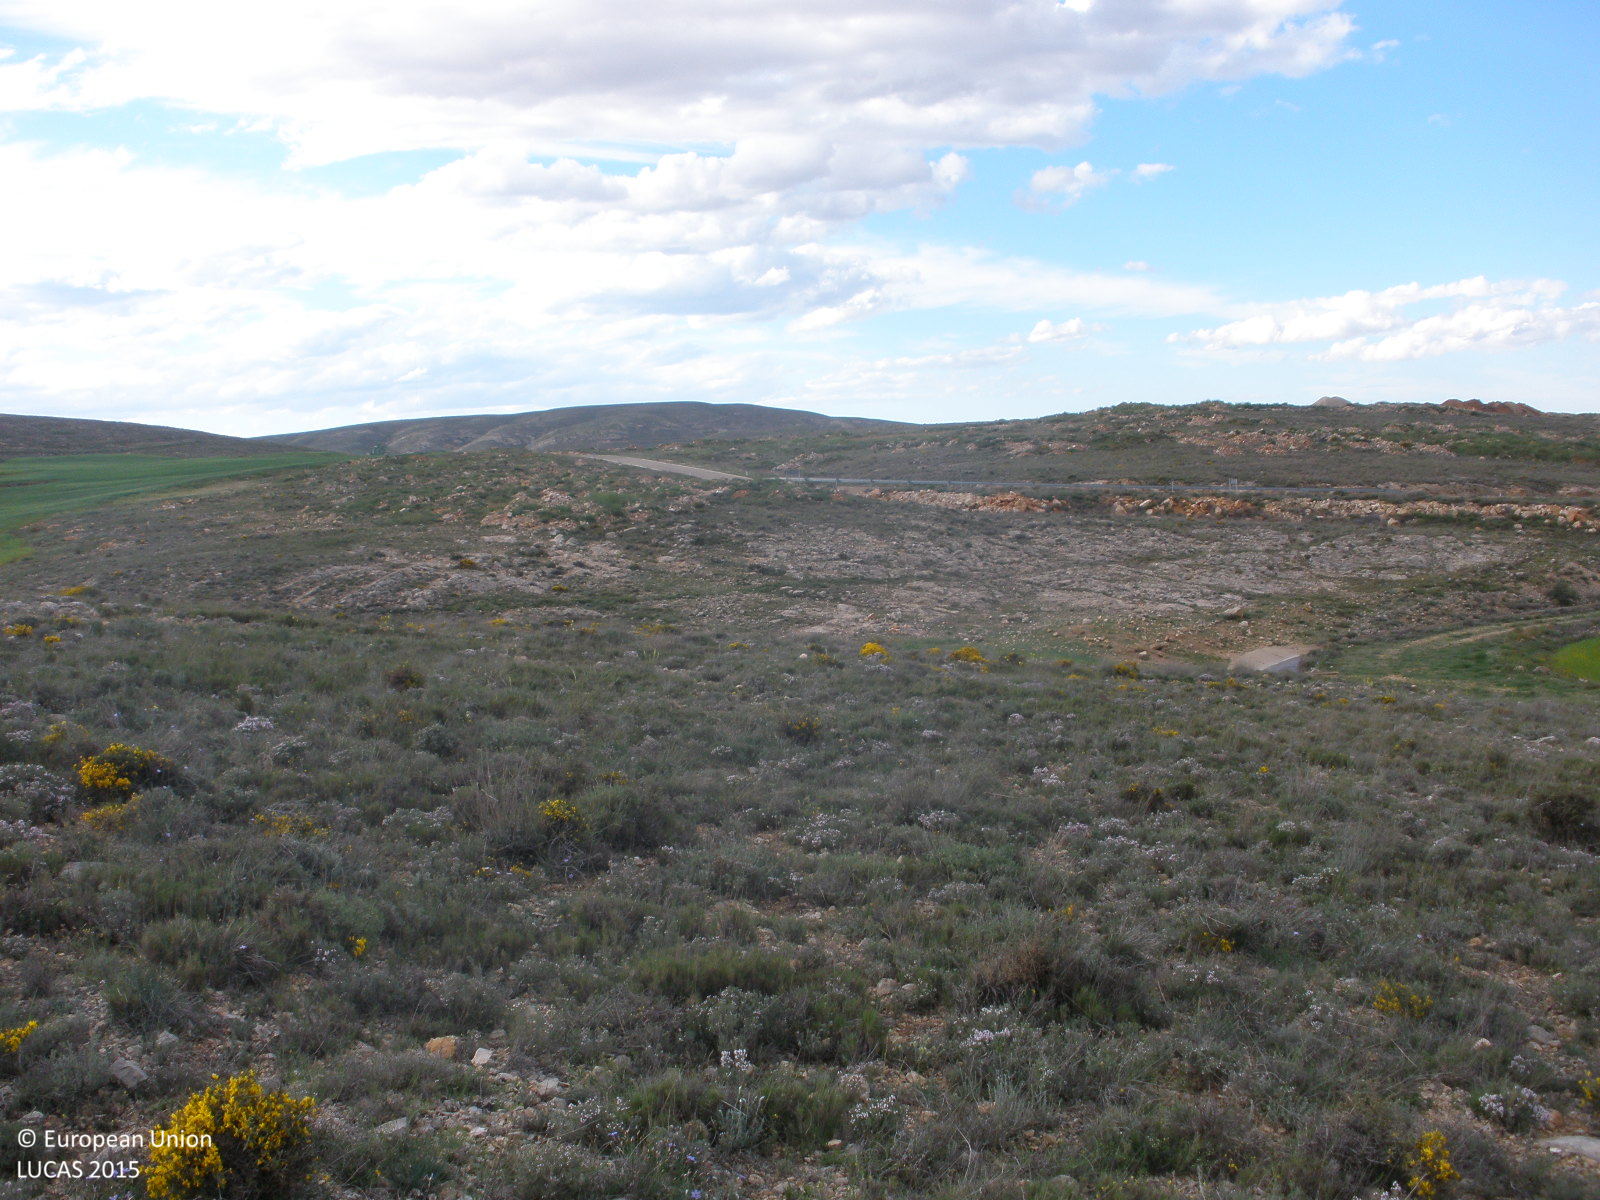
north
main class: Shrubland
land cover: Shrubland without tree cover
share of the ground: 50 - 75 %
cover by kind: shrubs 50 %, herbaceous plants 35 %, consolidated bare surface 15 %
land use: Semi-natural and natural areas not in use
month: May
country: ES
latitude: 41.0642
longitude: -0.8810
